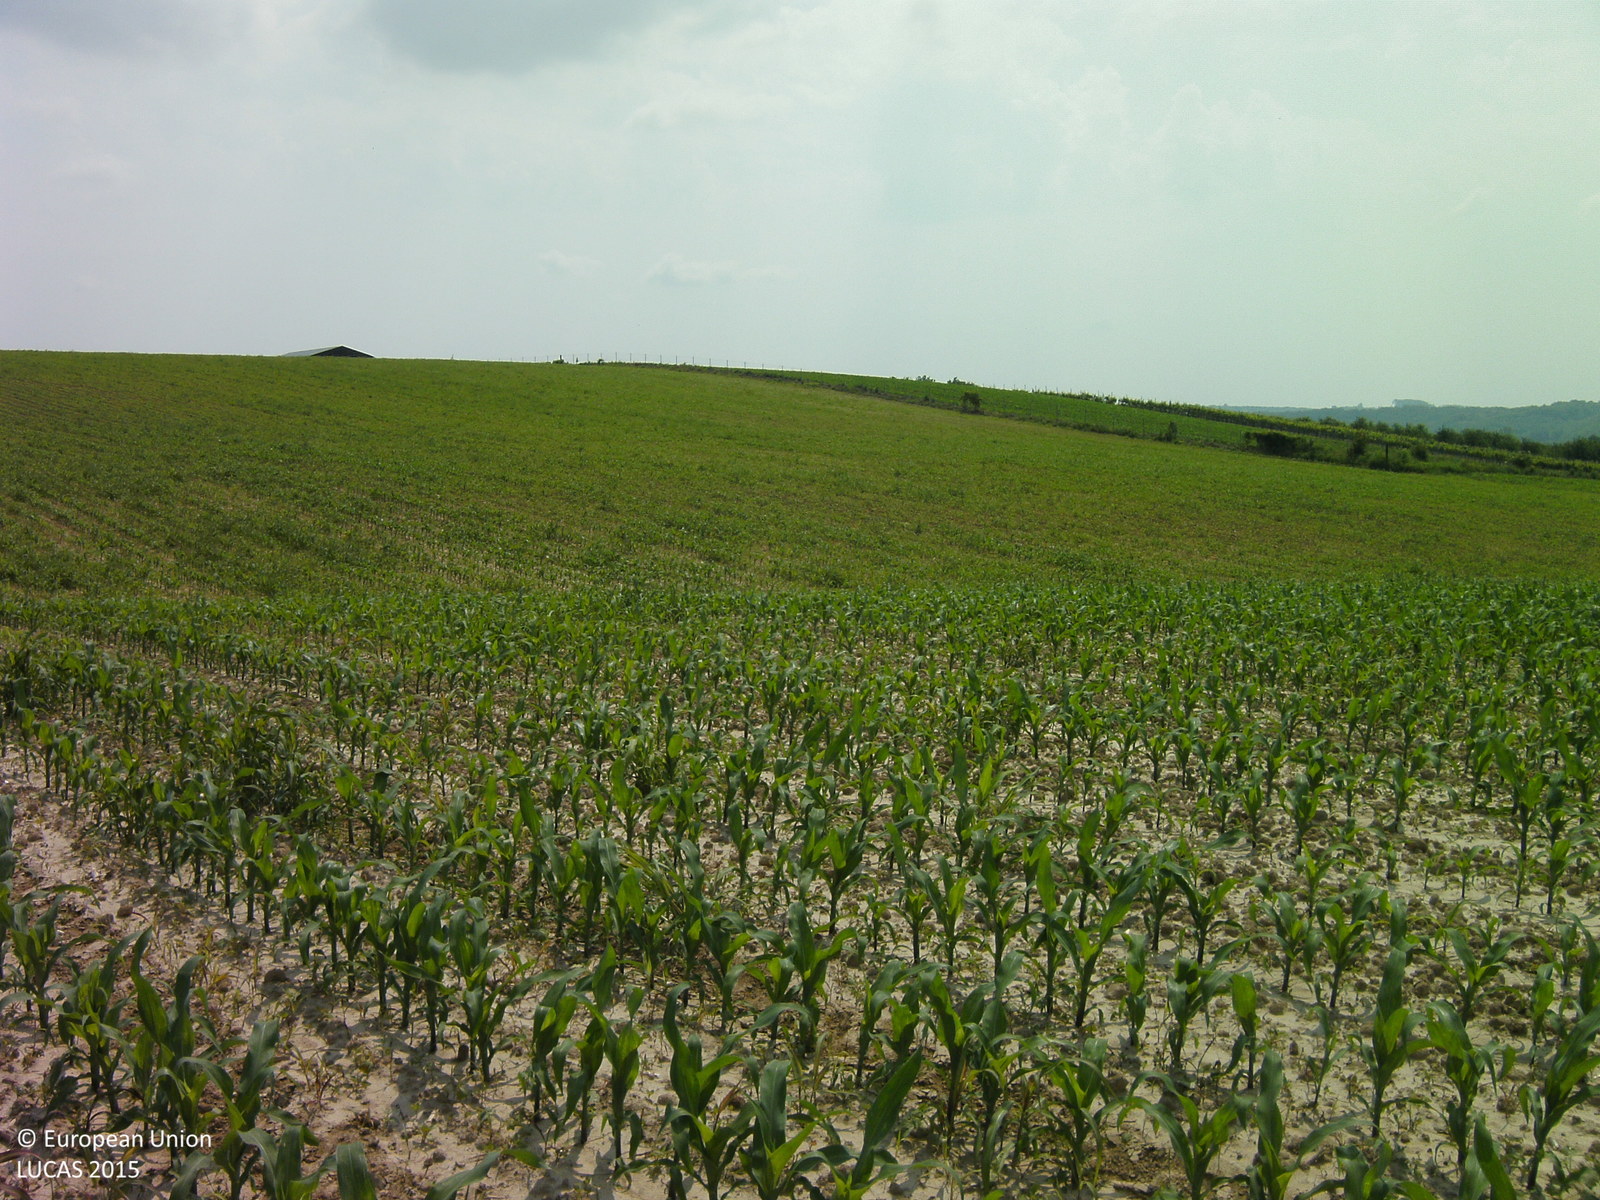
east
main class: Cropland
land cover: Maize
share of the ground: 10 - 25 %
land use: Agriculture (excluding fallow land and kitchen gardens)
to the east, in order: Maize
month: June
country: HU
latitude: 46.3704
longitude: 17.8448
